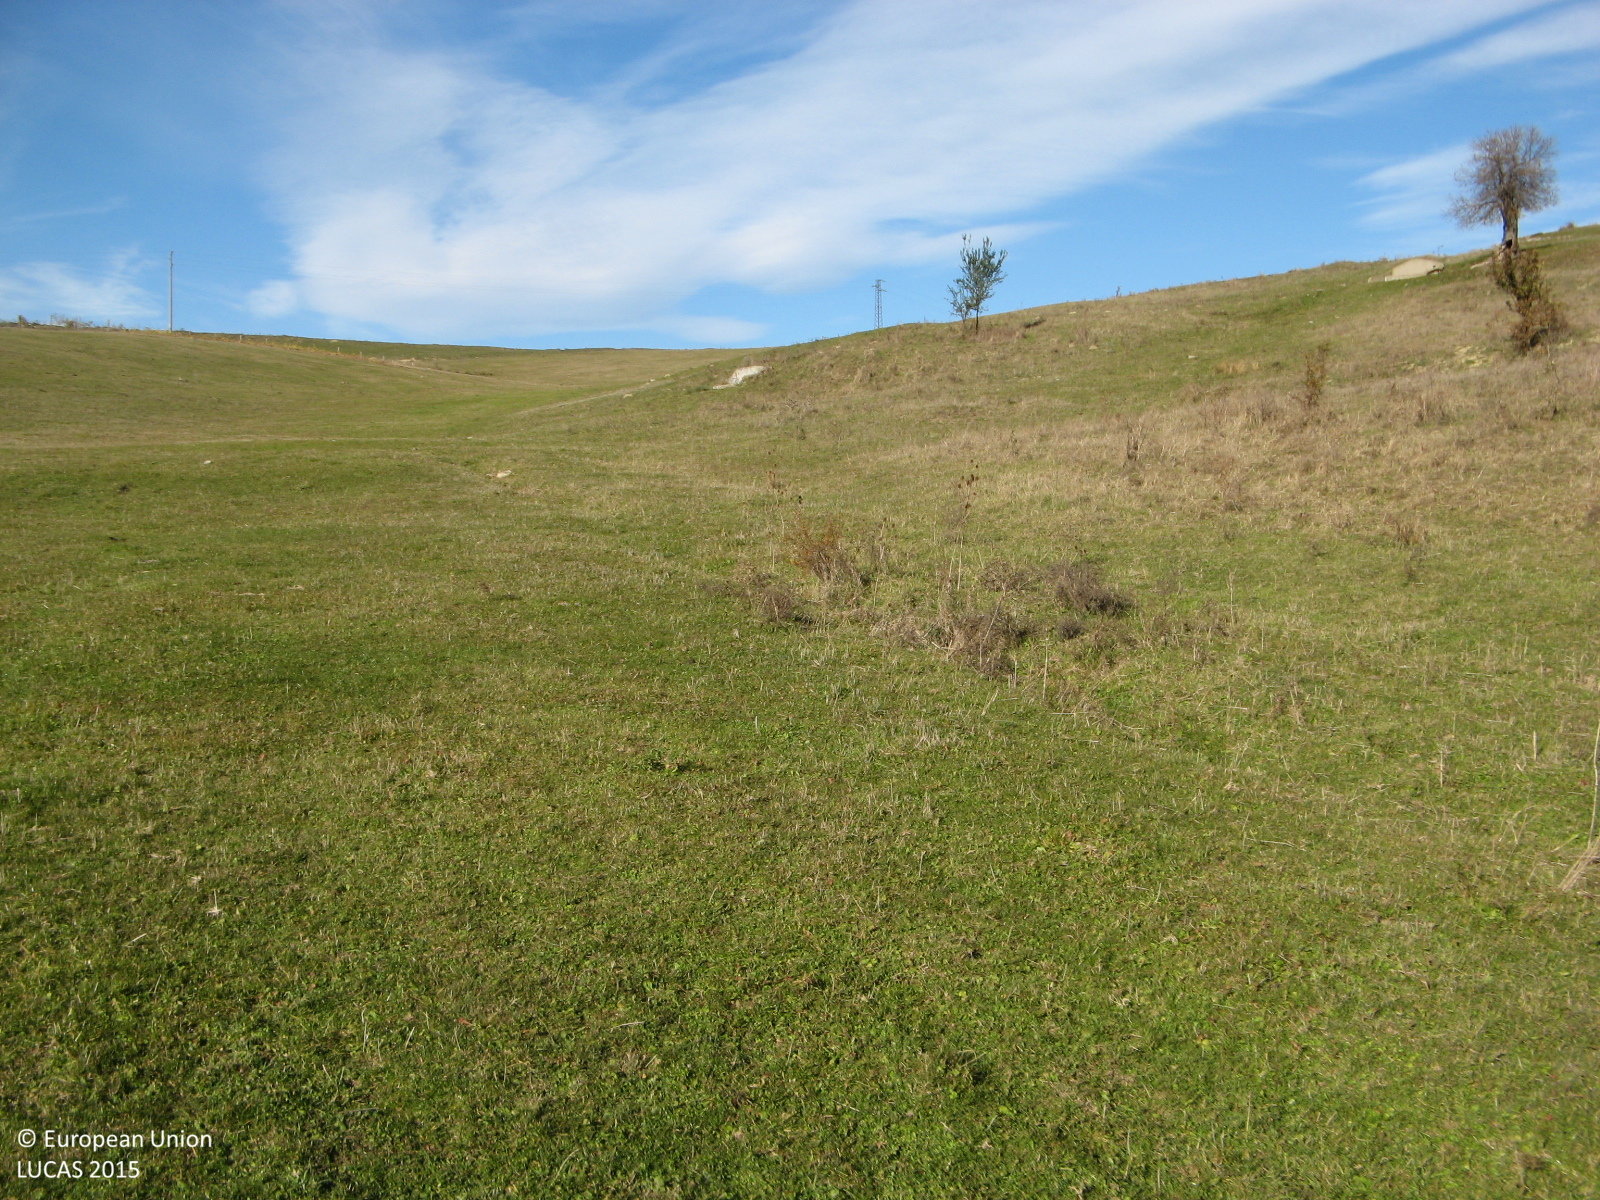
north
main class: Grassland
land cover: Grassland without tree/shrub cover
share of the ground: > 75 %
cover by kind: herbaceous plants 100 %
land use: Agriculture (excluding fallow land and kitchen gardens)
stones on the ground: < 10 %
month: November
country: BG
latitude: 41.7626
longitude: 25.3948
